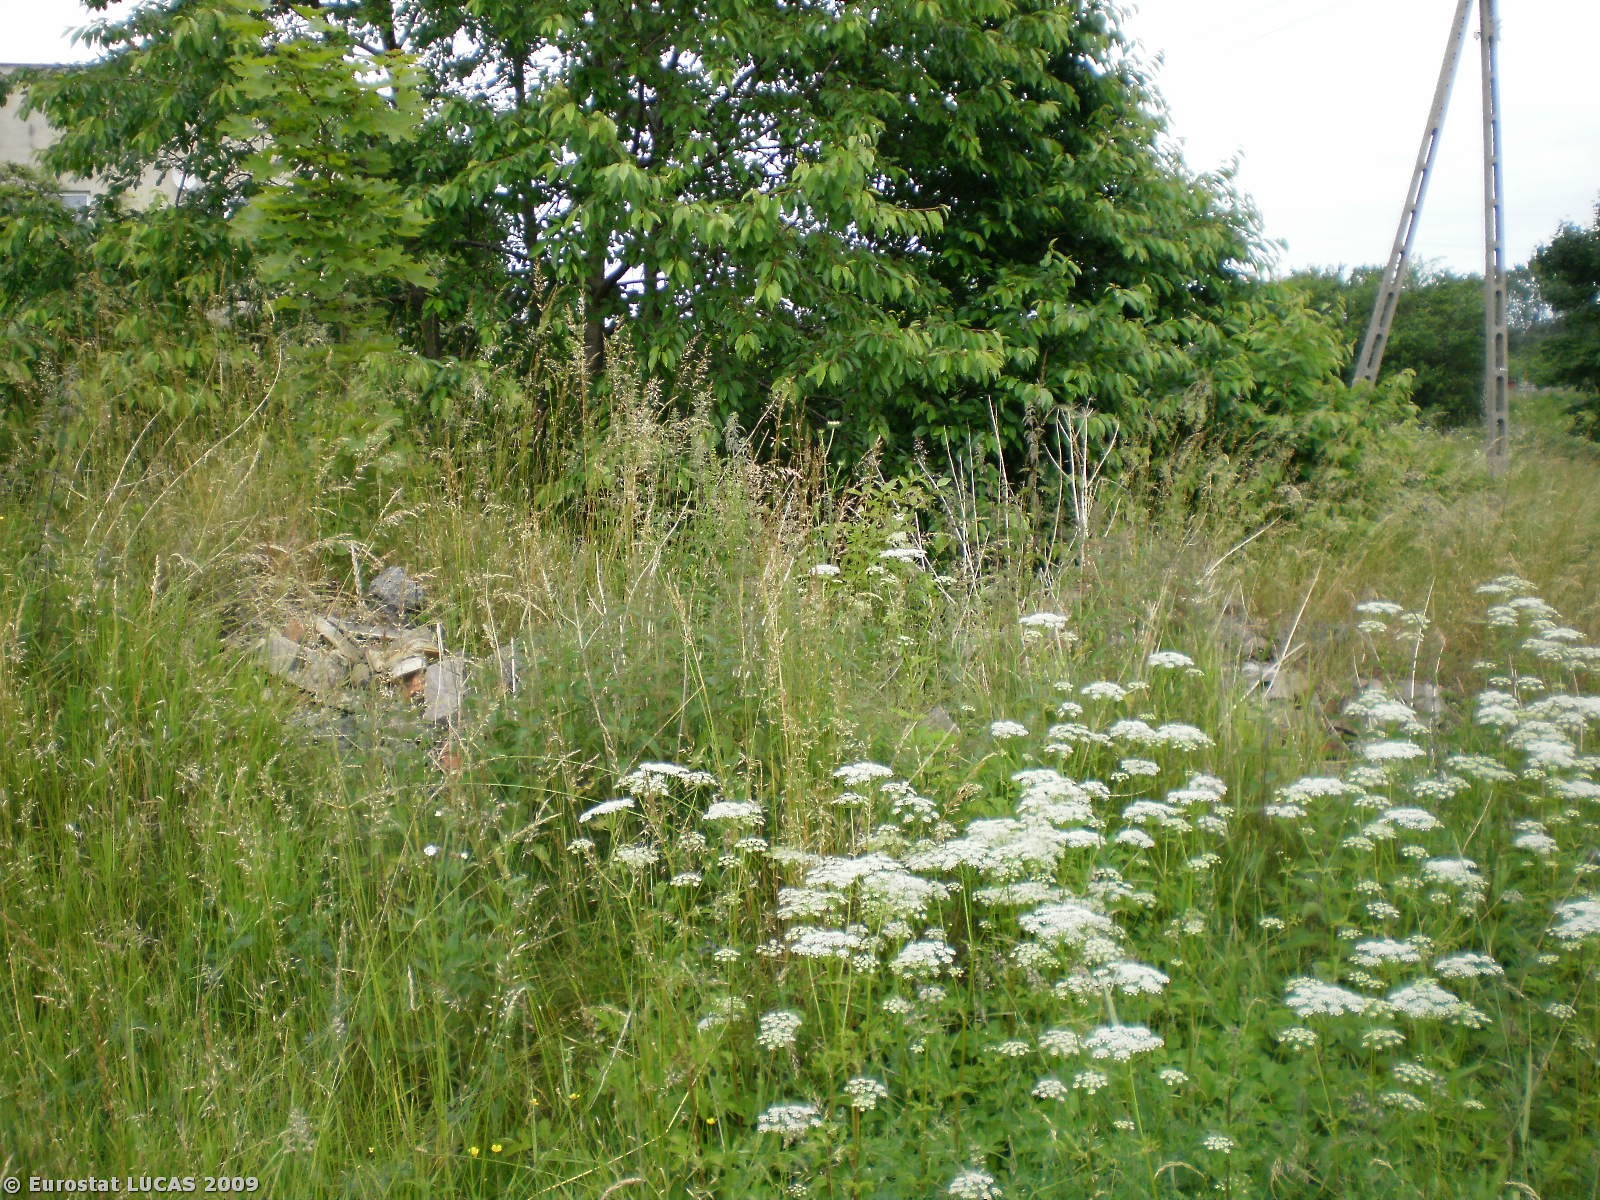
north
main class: Grassland
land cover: Grassland with sparse tree/shrub cover
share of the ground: > 75 %
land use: Unused
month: June
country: PL
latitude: 54.4597
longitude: 18.4858
